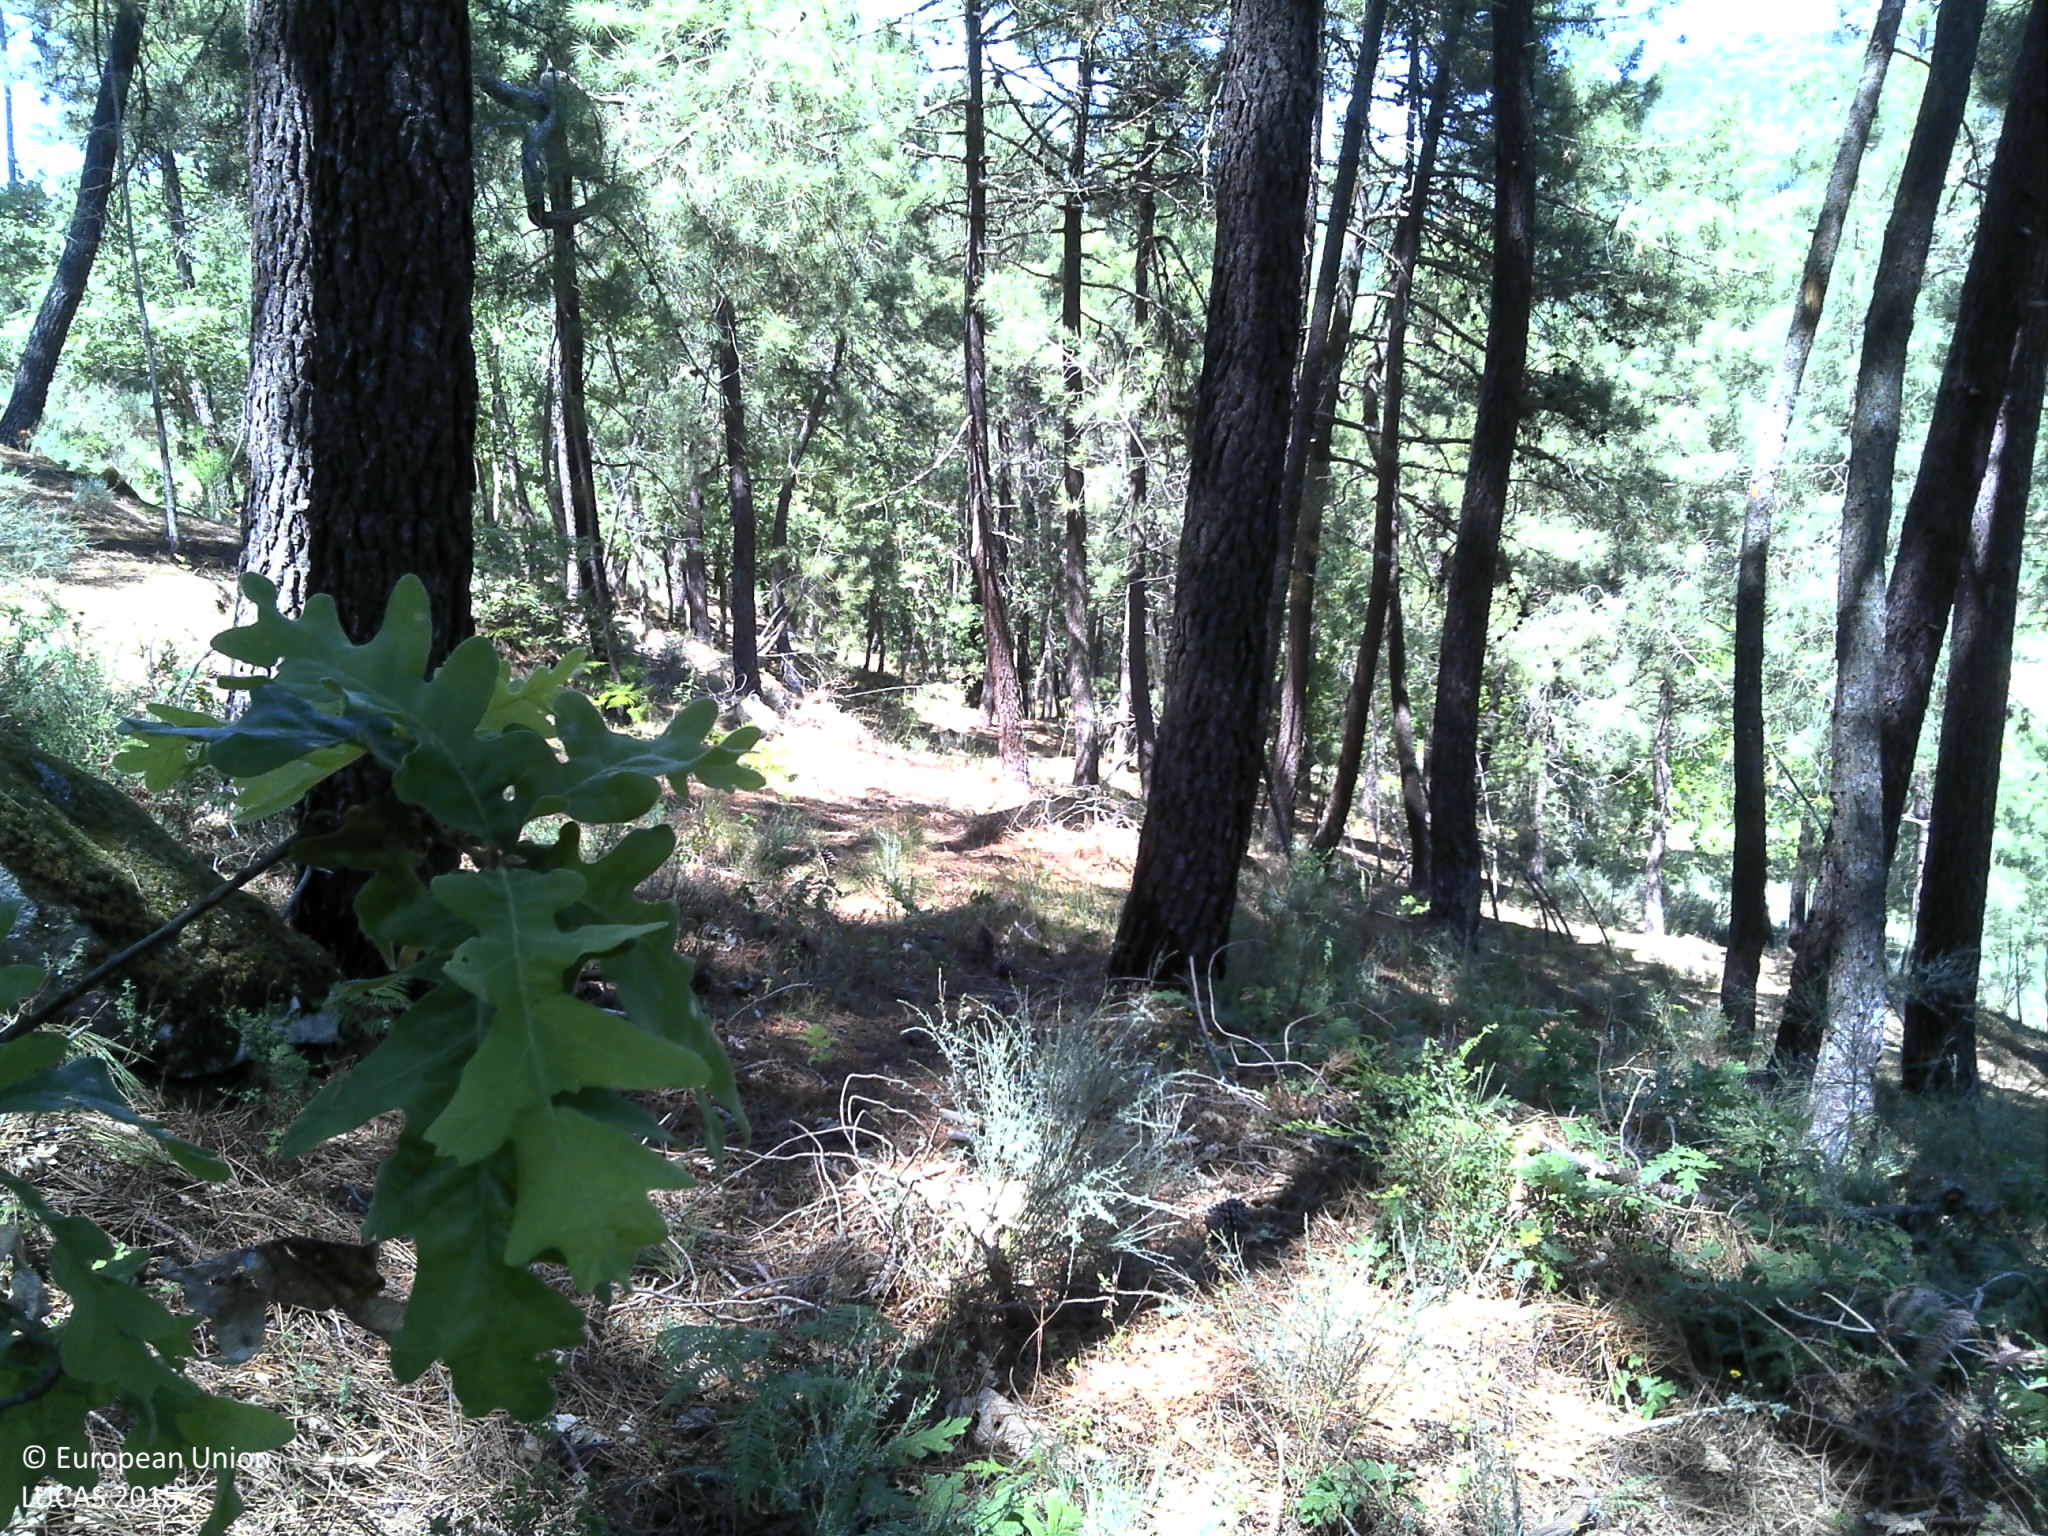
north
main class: Woodland
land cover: Pine dominated coniferous woodland
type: coniferous forest of the mediterranean region
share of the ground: 50 - 75 %
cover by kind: coniferous forest trees 60 %, shrubs 30 %, broadleaved forest trees 5 %, unconsolidated bare surface 5 %
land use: Forestry
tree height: > 5 m
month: May
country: PT
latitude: 41.5936
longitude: -7.5123
